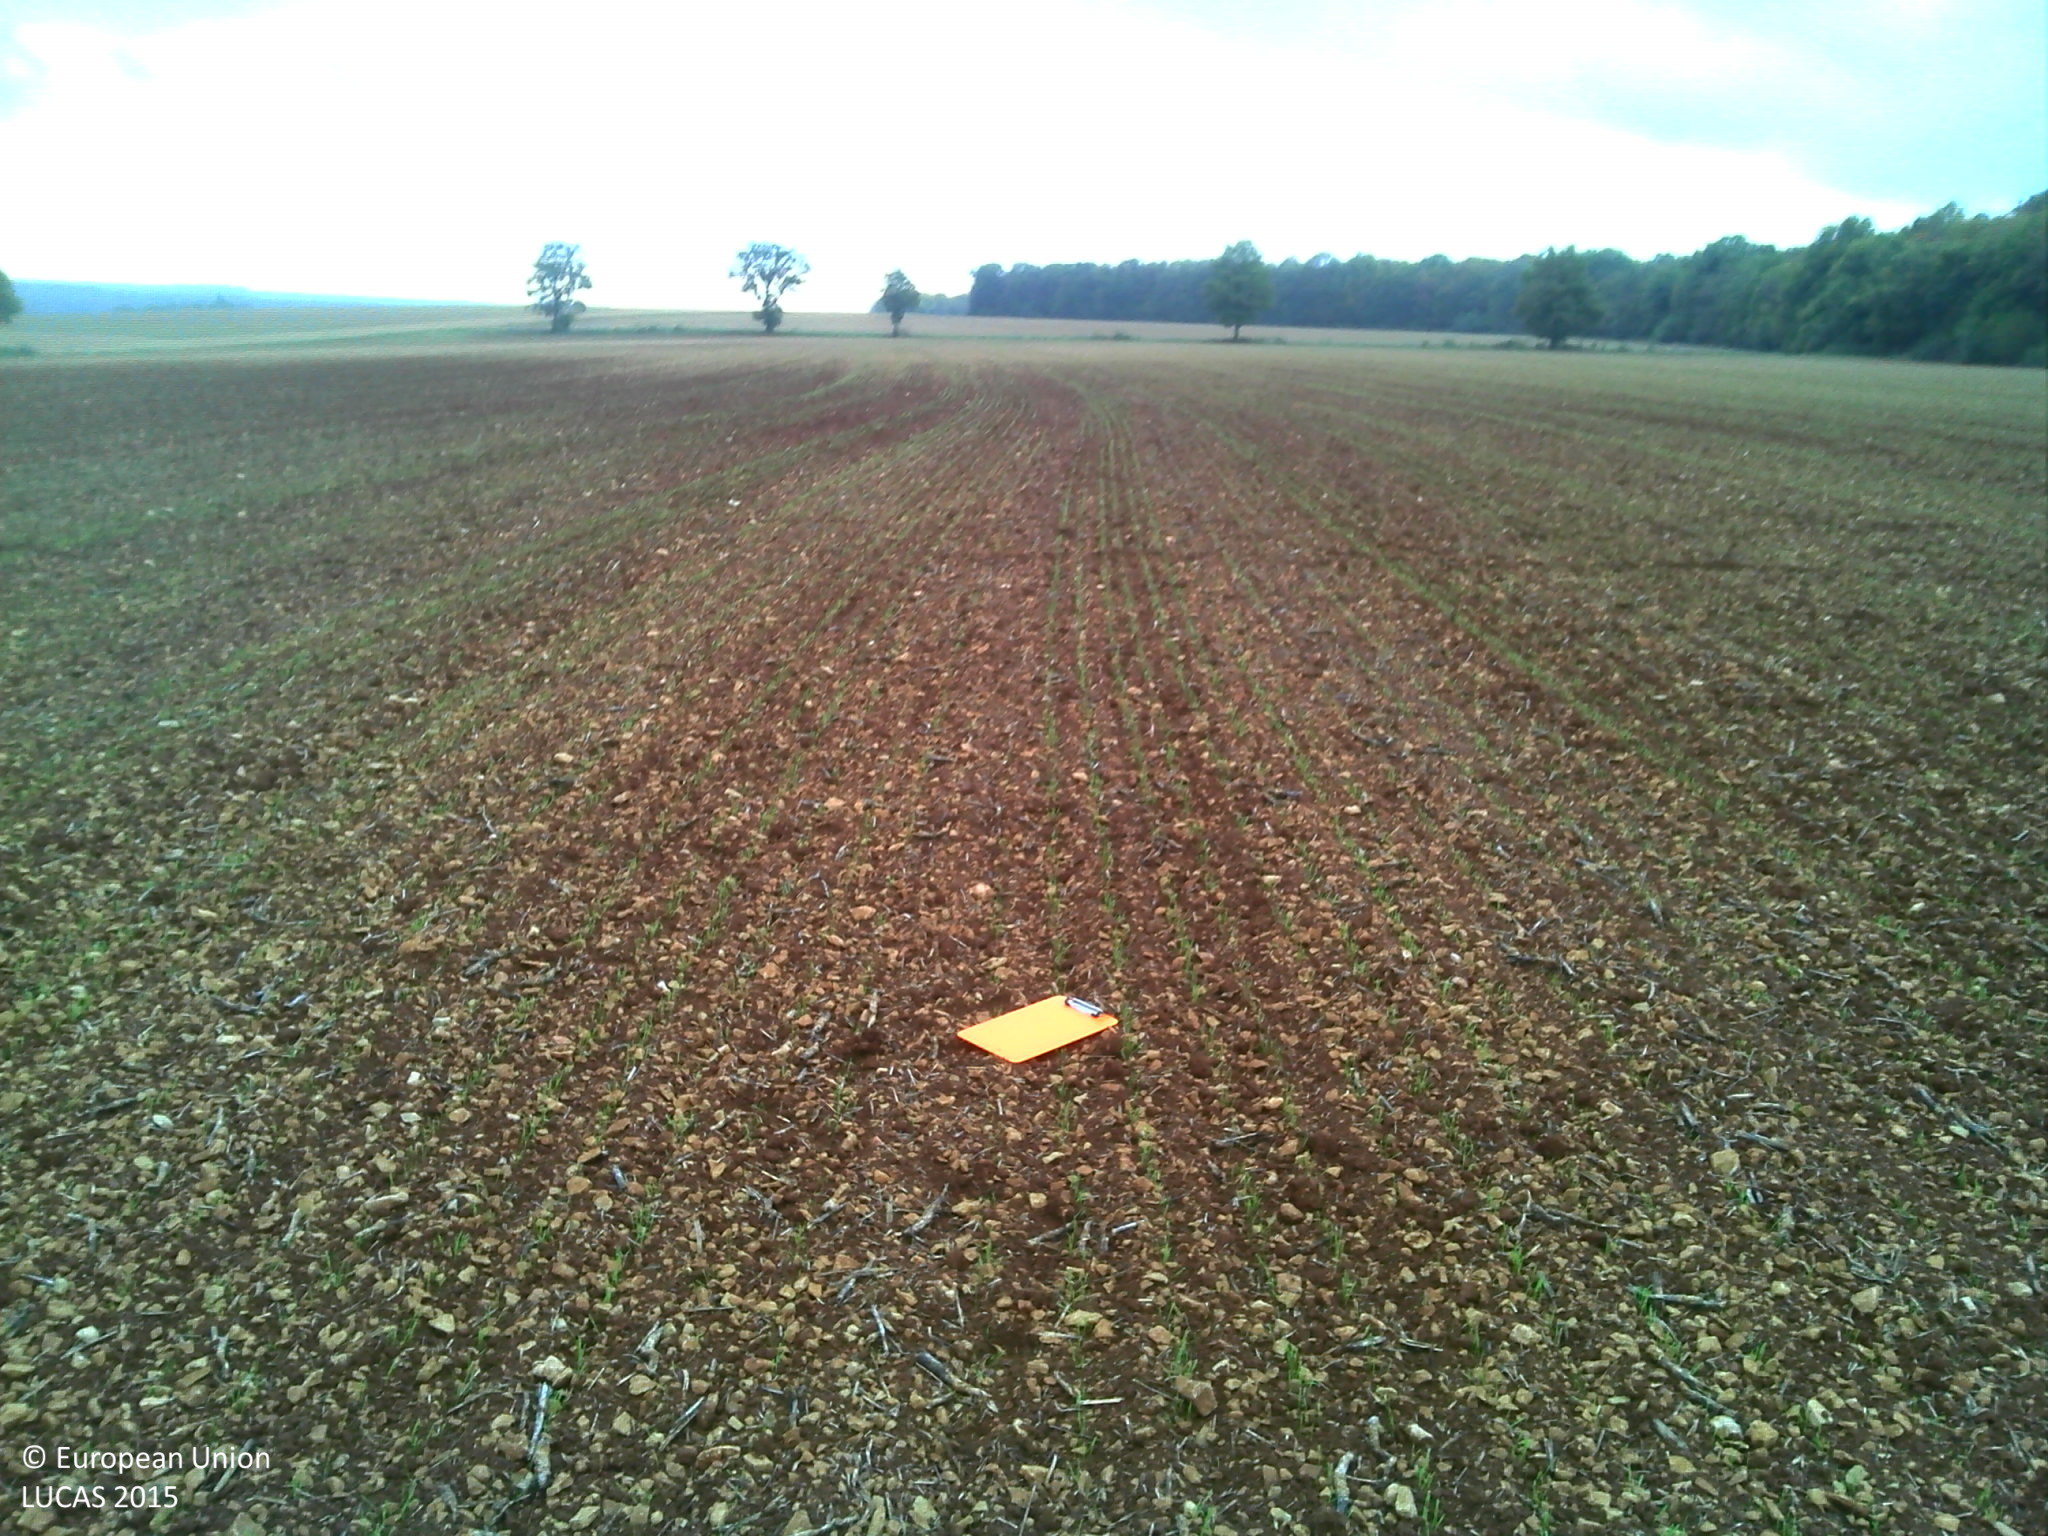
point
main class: Cropland
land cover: Common wheat
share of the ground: < 10 %
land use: Agriculture (excluding fallow land and kitchen gardens)
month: October
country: FR
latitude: 47.5879
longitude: 5.0134
